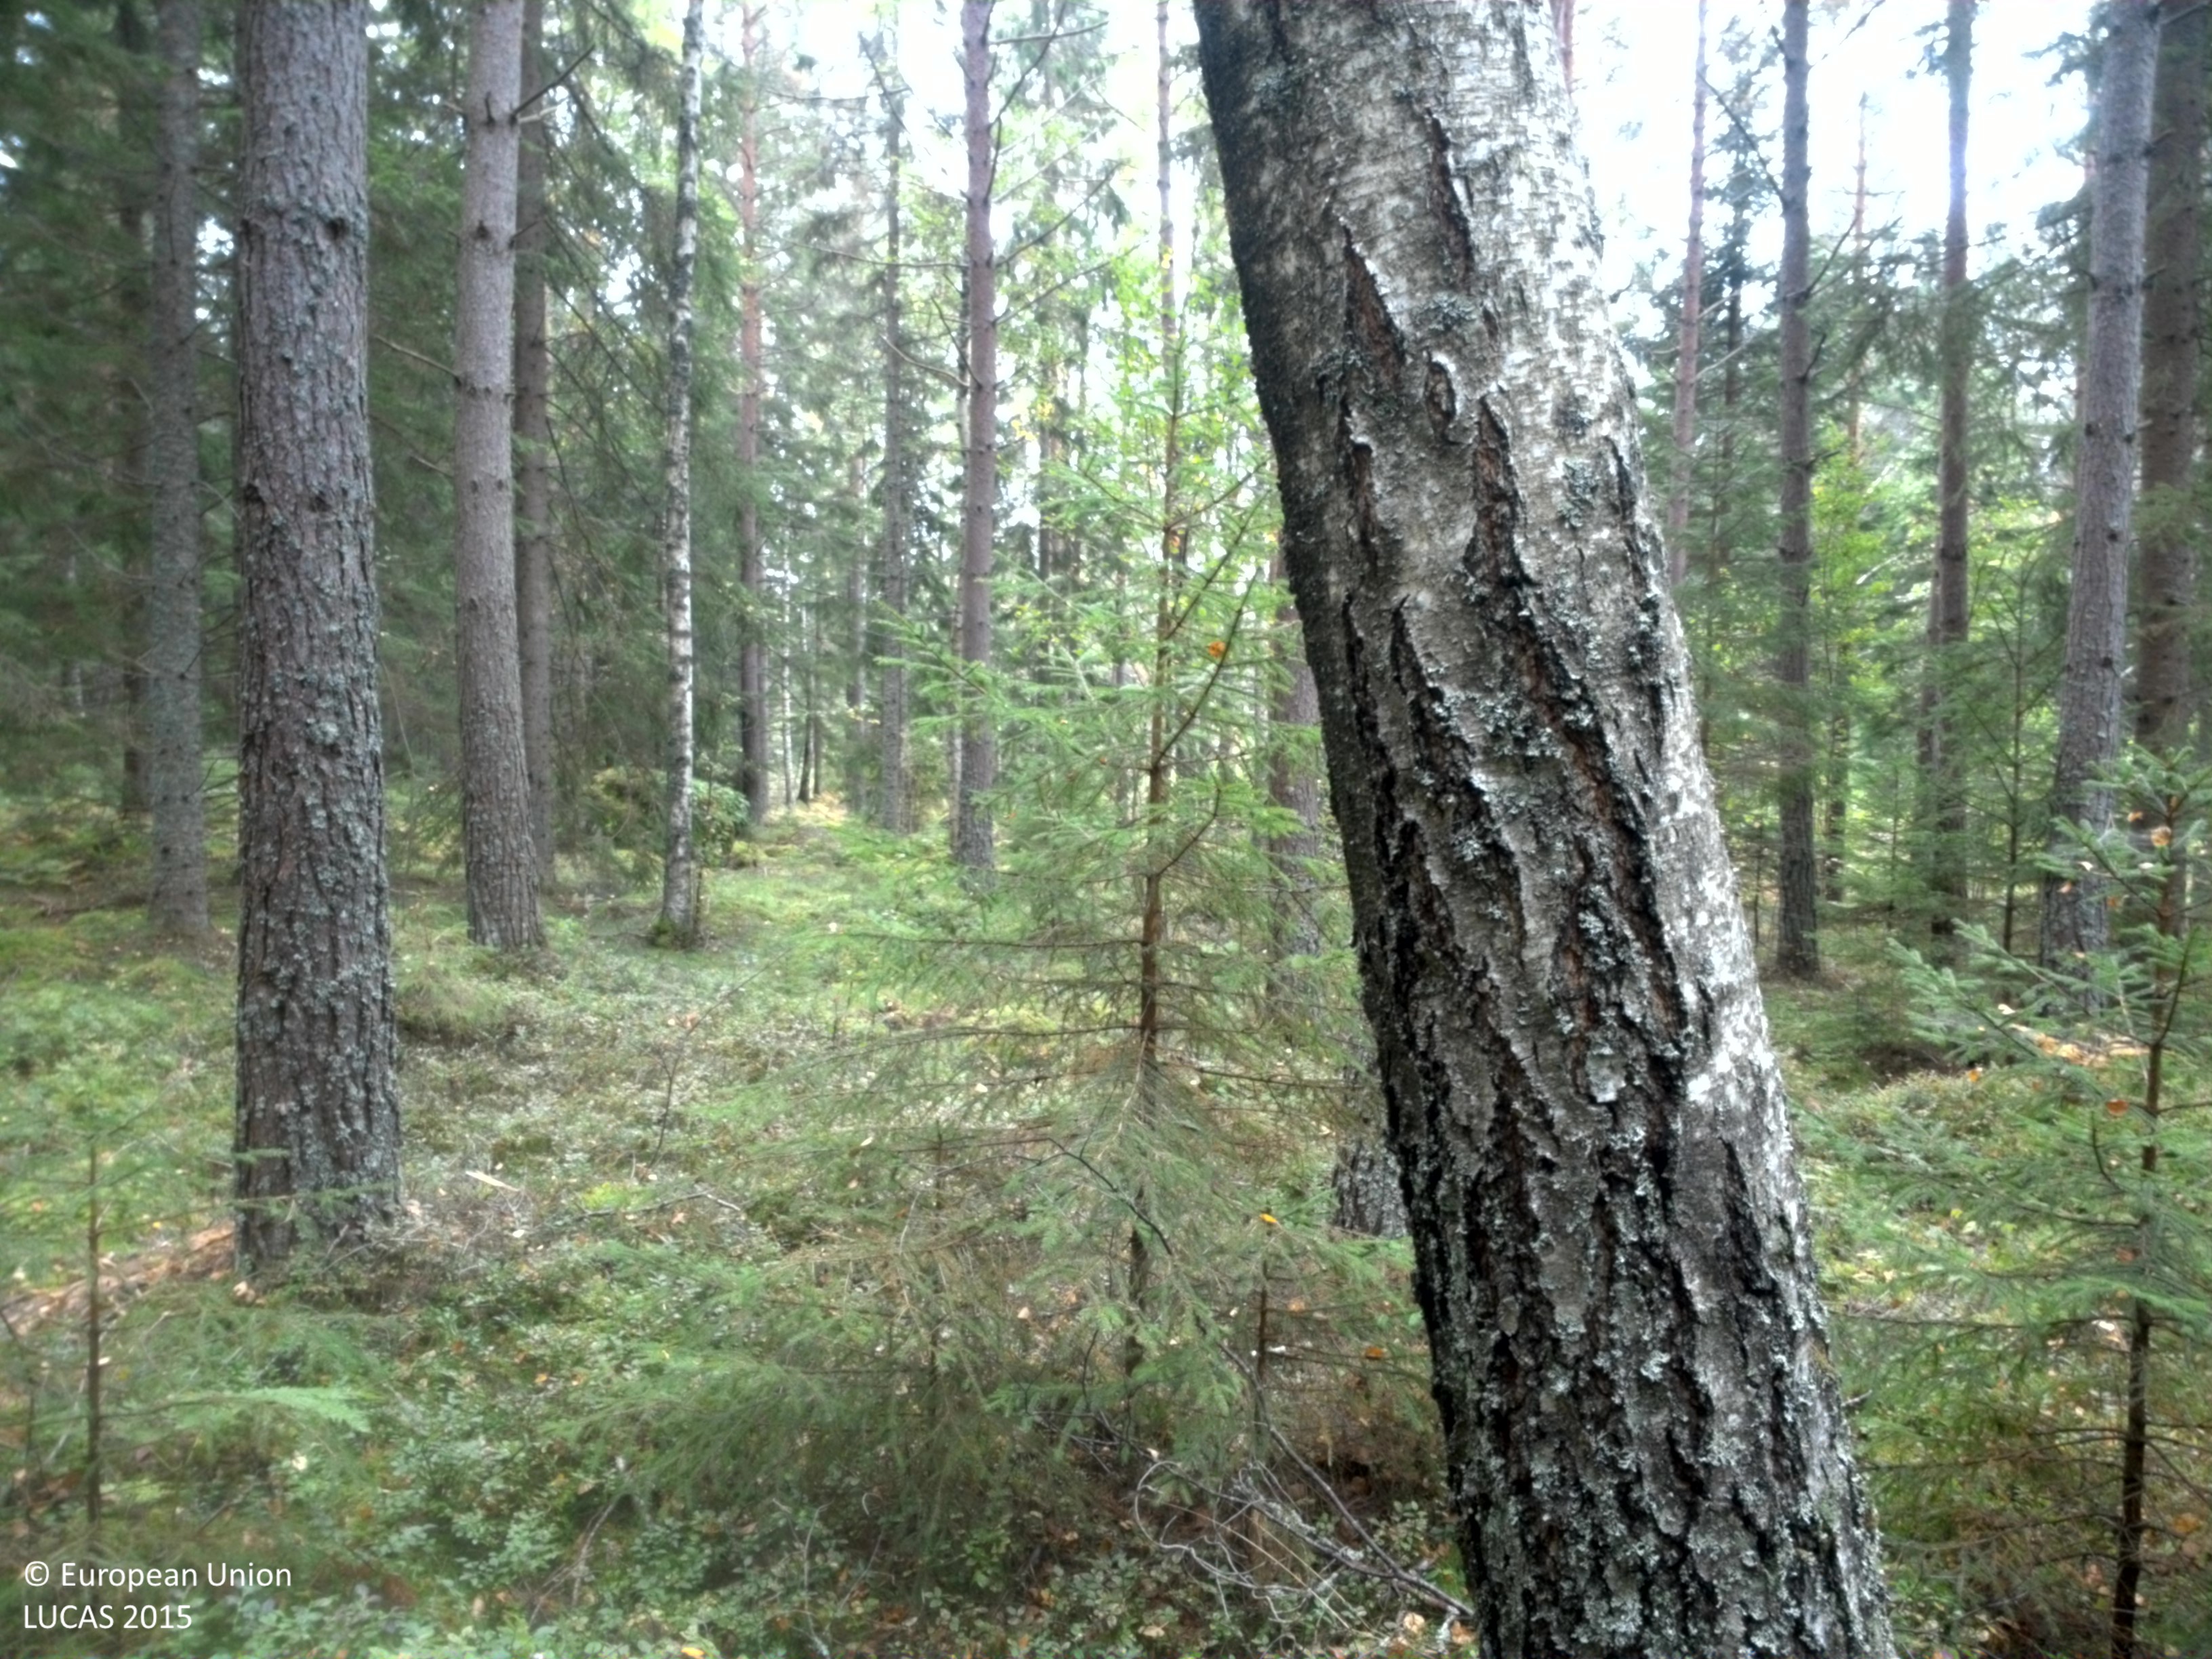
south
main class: Woodland
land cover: Other coniferous woodland
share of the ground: 25 - 50 %
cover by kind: coniferous forest trees 40 %, shrubs 25 %, lichens and mosses 20 %, broadleaved forest trees 10 %, herbaceous plants 5 %
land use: Forestry
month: September
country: SE
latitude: 58.8426
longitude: 14.0650
